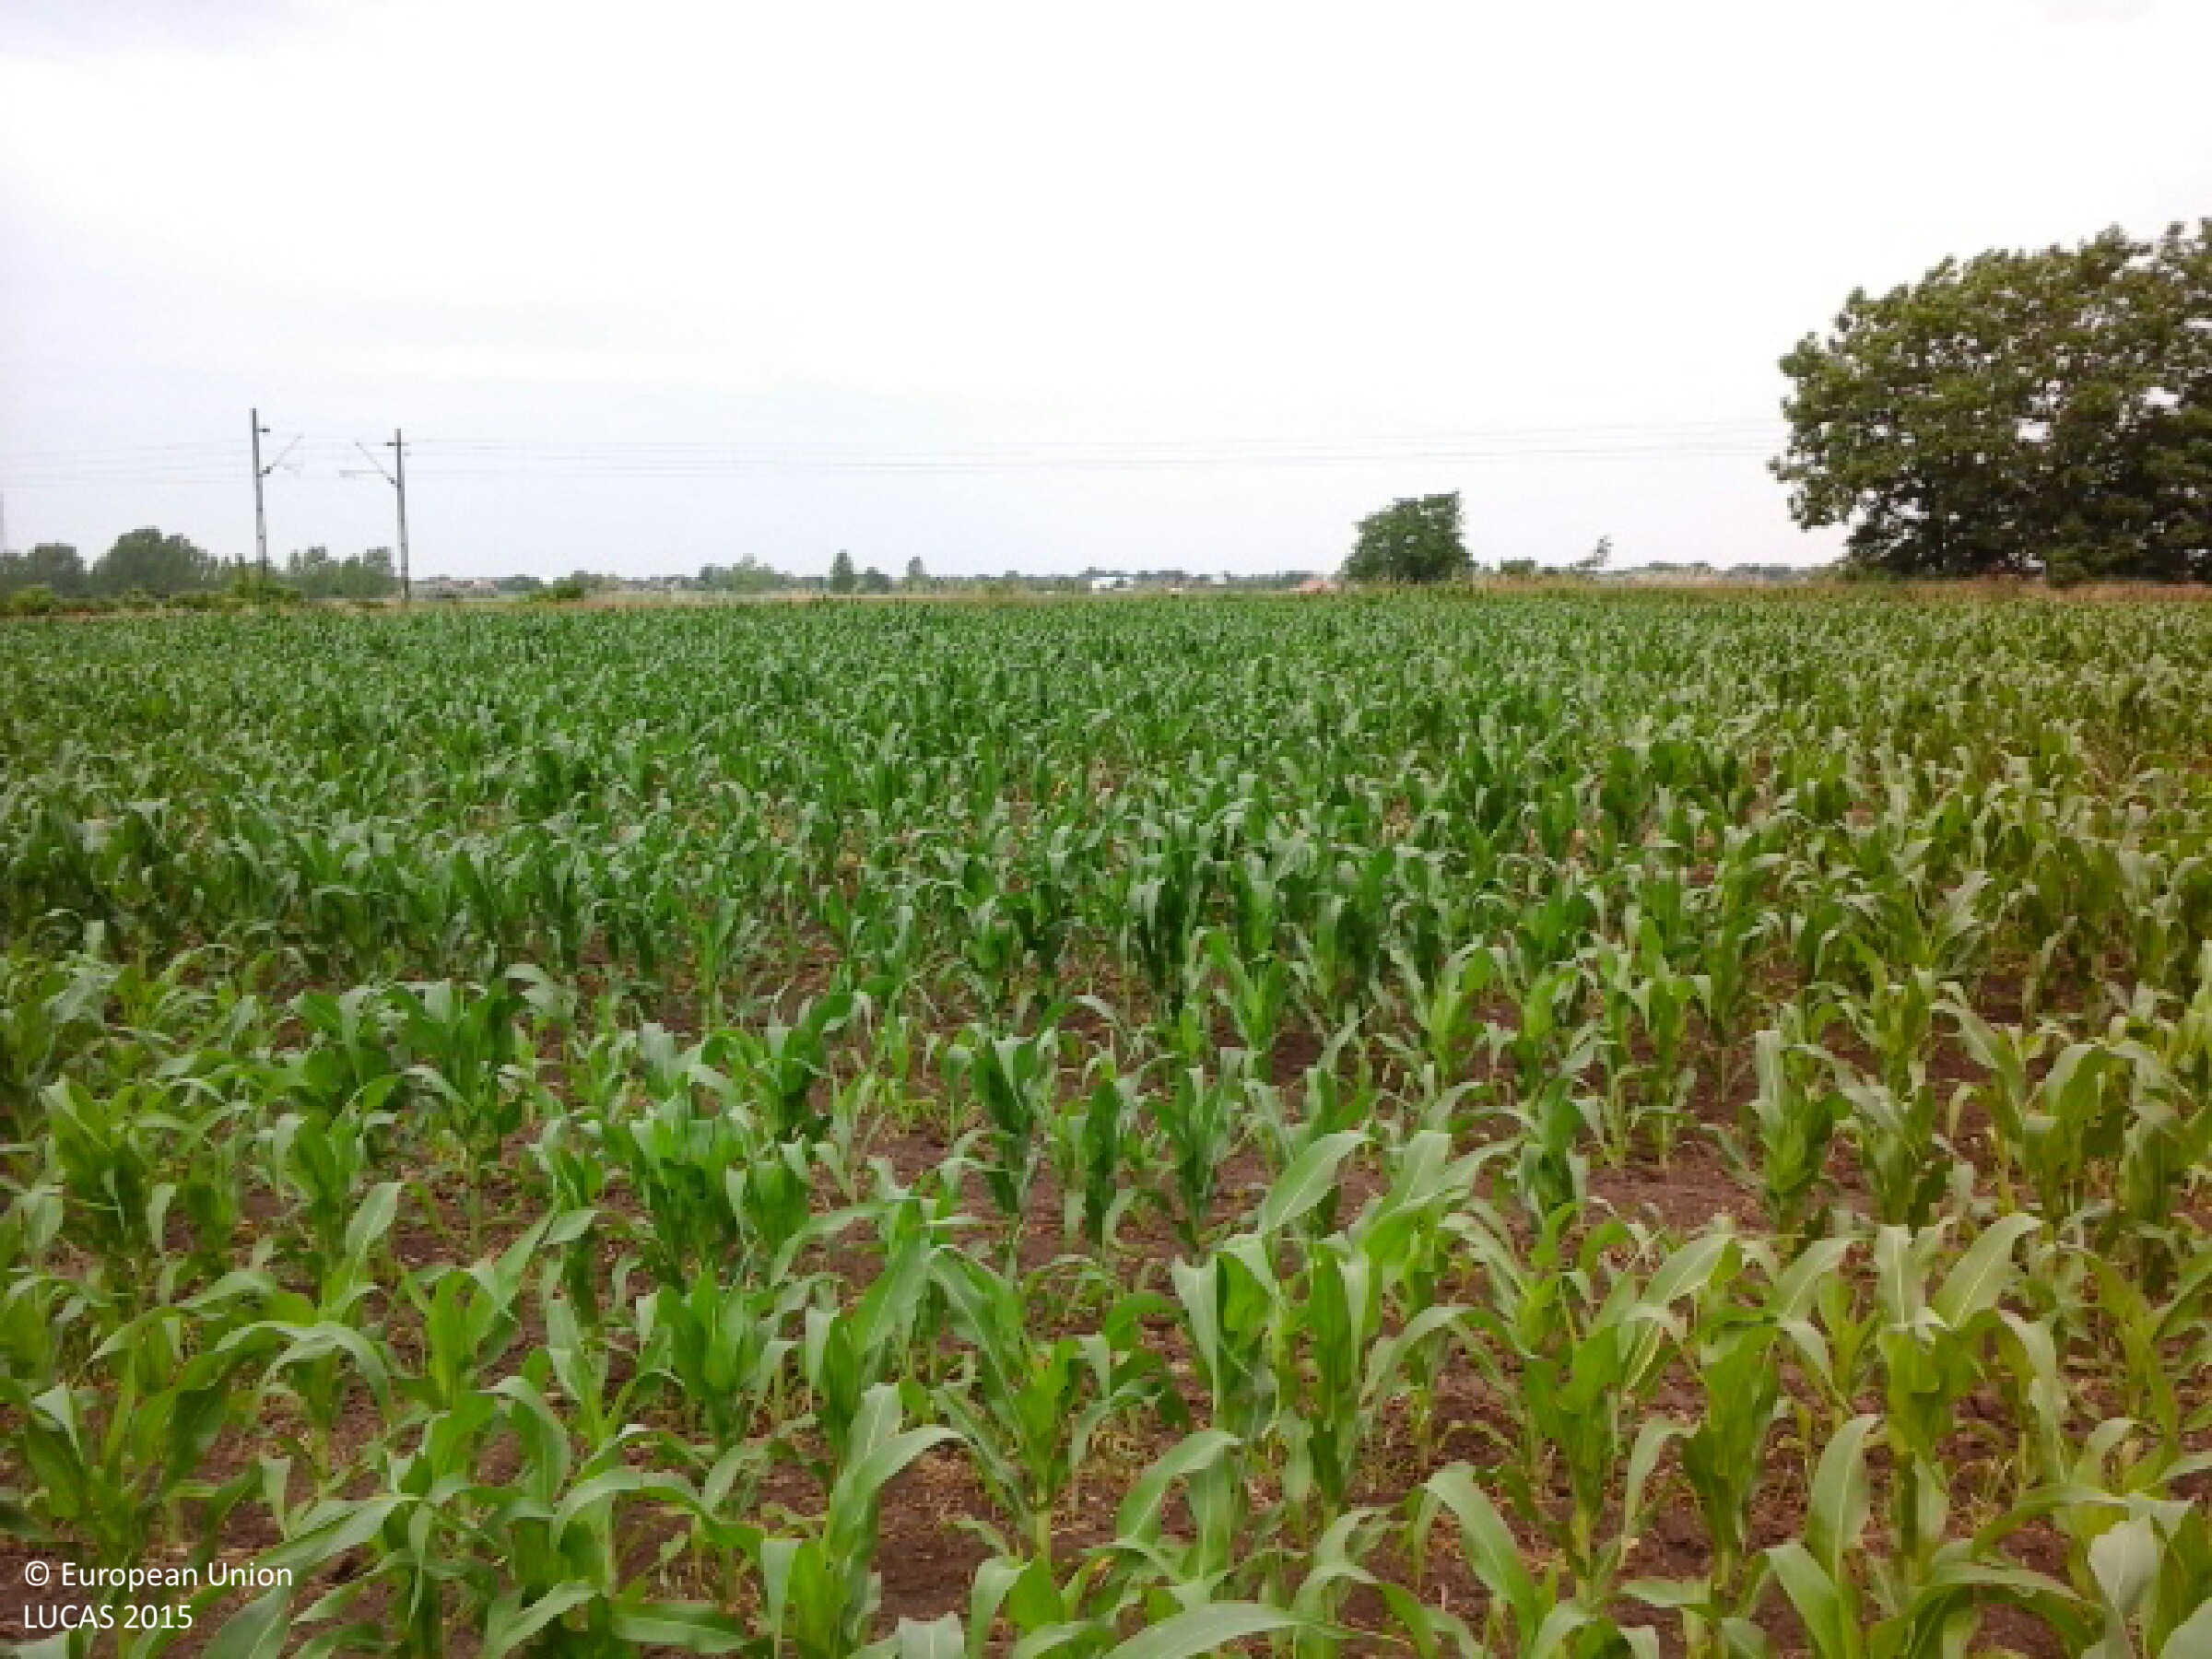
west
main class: Cropland
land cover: Maize
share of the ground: 50 - 75 %
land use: Agriculture (excluding fallow land and kitchen gardens)
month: June
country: HU
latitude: 47.7801
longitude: 21.6980
